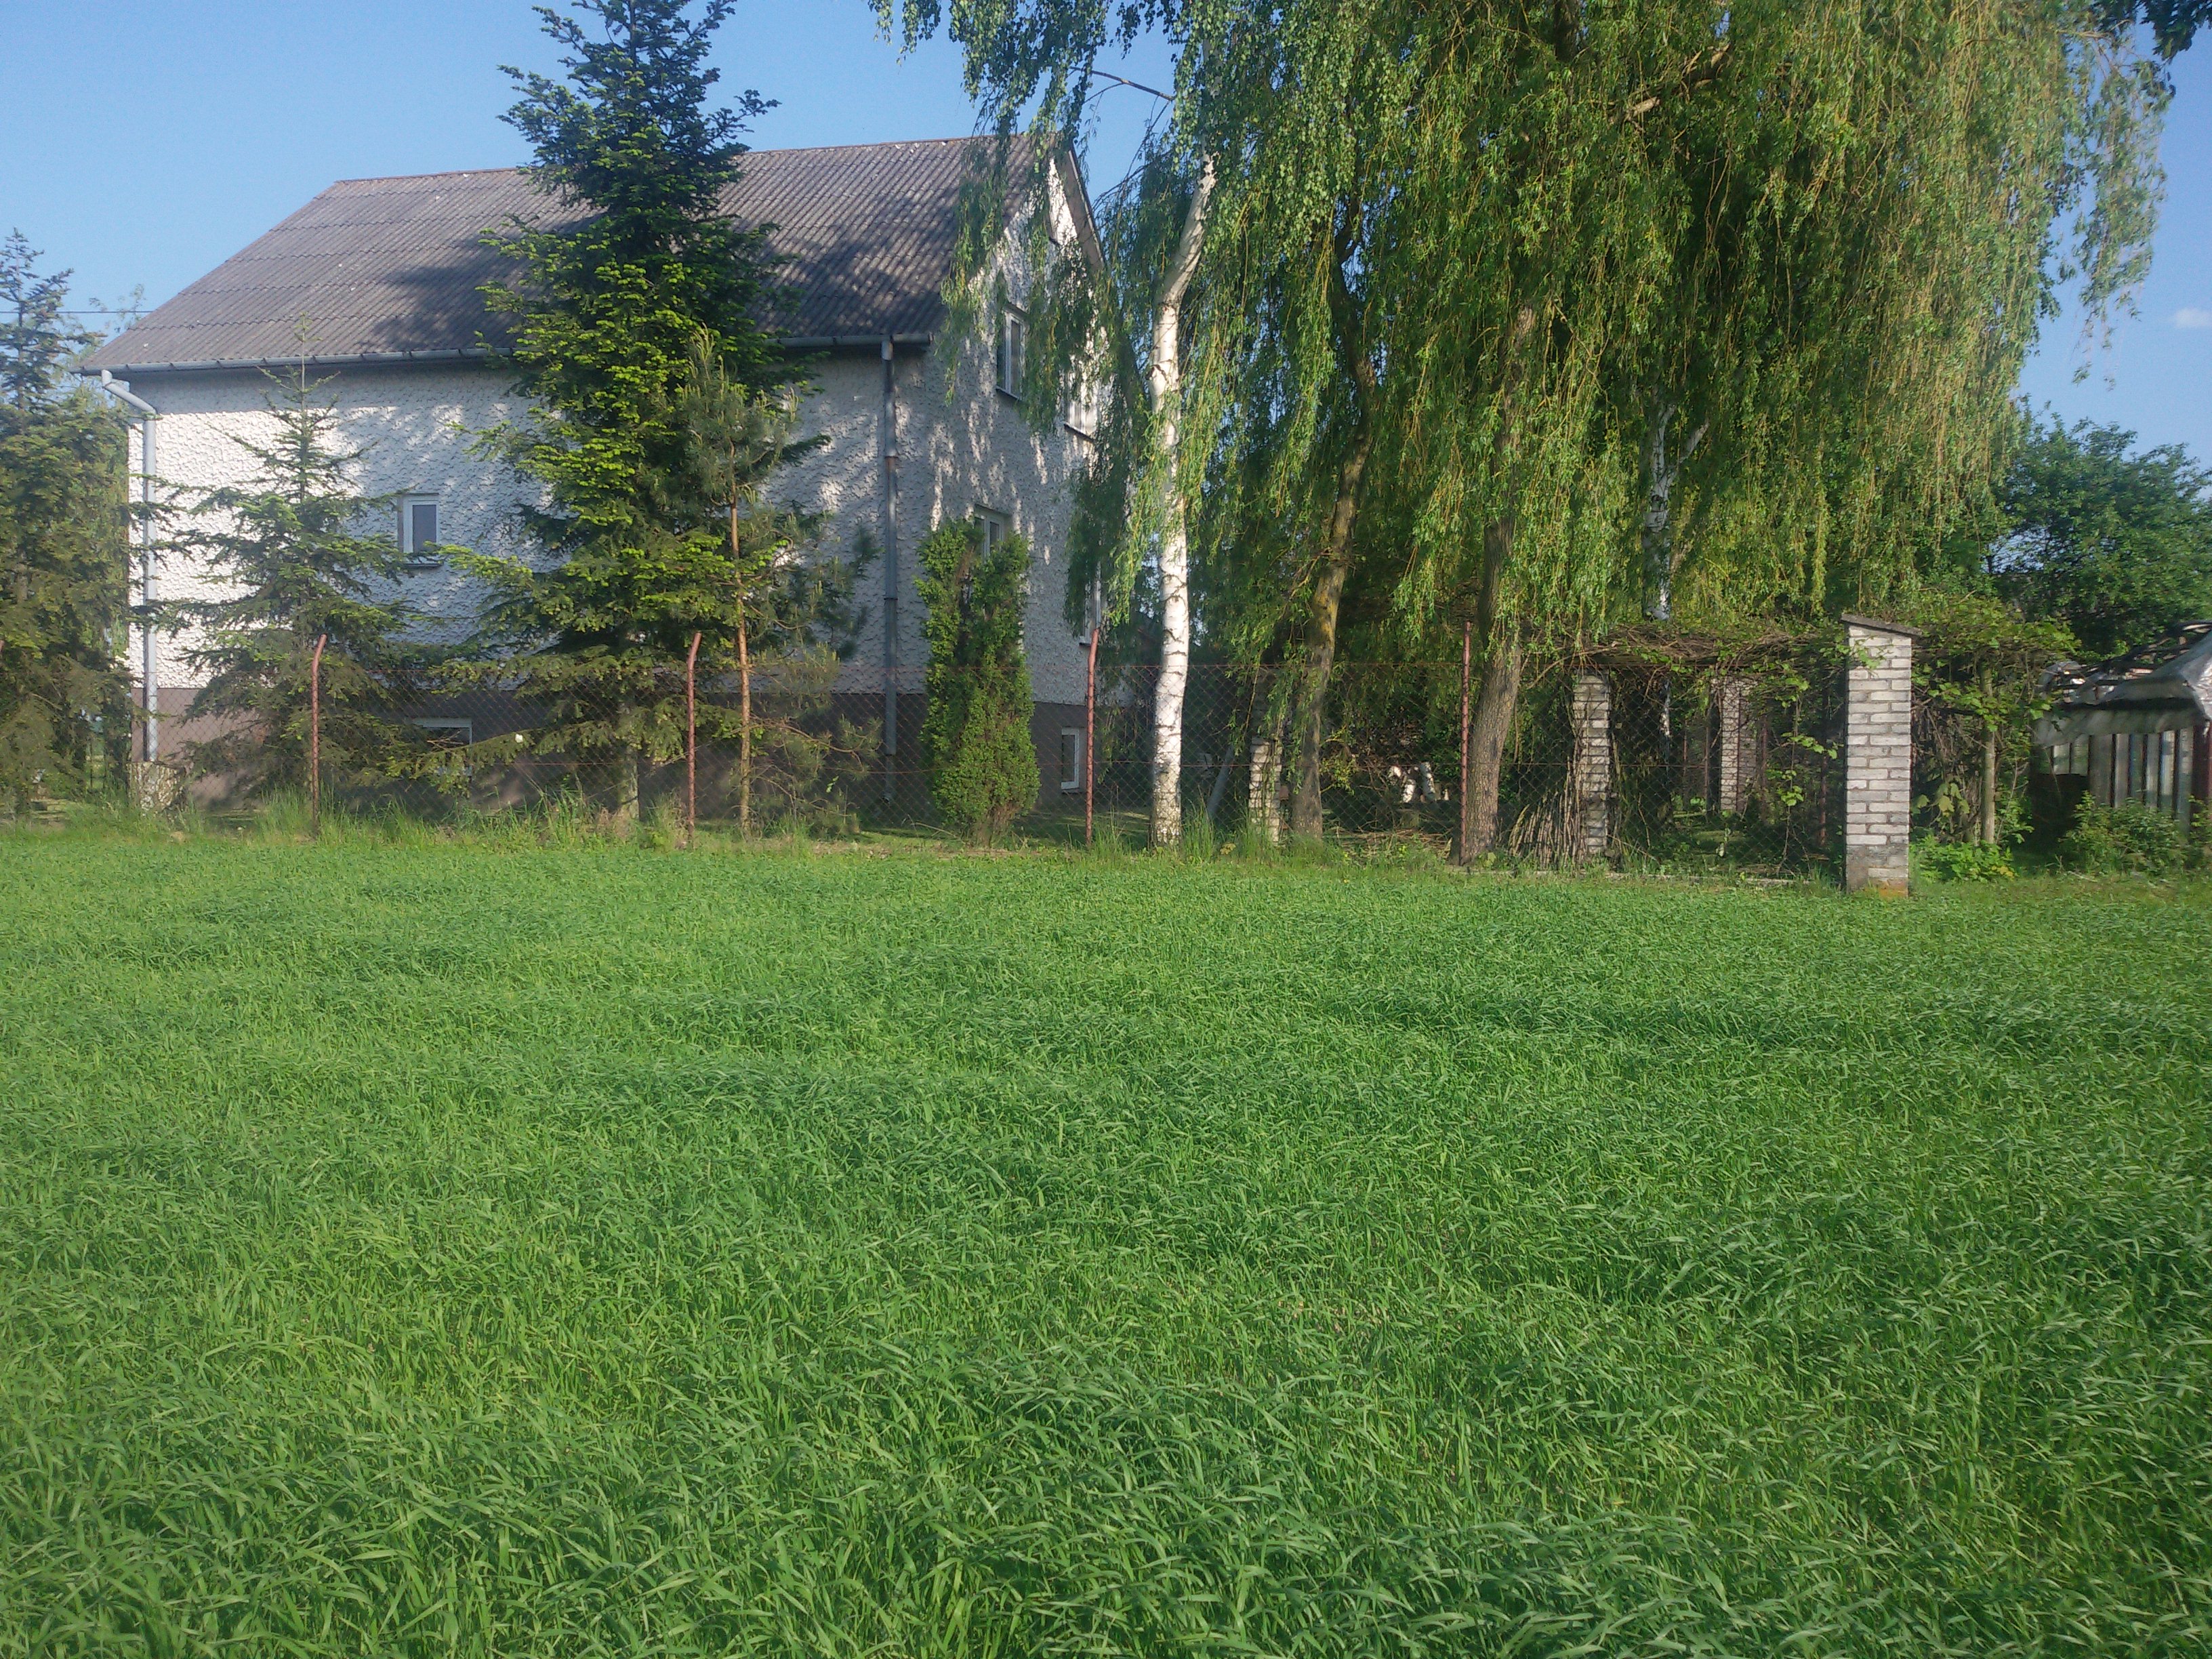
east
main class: Cropland
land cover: Common wheat
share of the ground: > 75 %
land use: Agriculture (excluding fallow land and kitchen gardens)
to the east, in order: Common wheat; Electric lines; Common wheat; Artificial constructions in urban areas; Sugar beet; Managed hedges; Sugar beet; Grass margins; Sugar beet; Grass margins; Common wheat; Grass margins; Sugar beet; Electric lines; Sugar beet
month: May
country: PL
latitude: 51.2513
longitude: 22.8962
